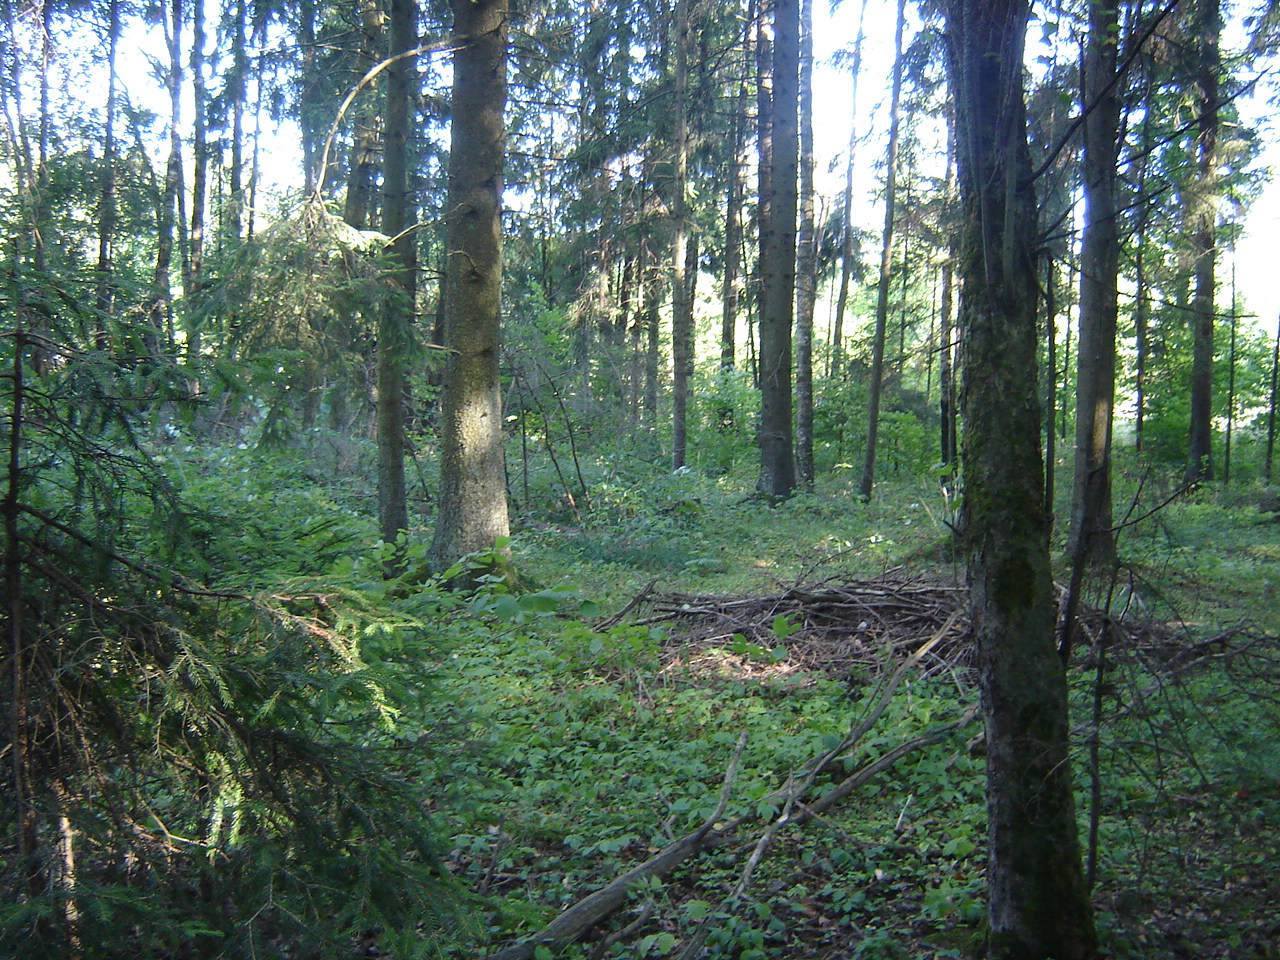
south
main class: Woodland
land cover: Spruce dominated mixed woodland
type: hemiboreal forest and nemoral coniferous forest and mixed broadleaved-coniferous forest
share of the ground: > 75 %
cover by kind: coniferous forest trees 60 %, broadleaved forest trees 30 %, herbaceous plants 5 %, unconsolidated bare surface 5 %
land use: Forestry
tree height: > 5 m
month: August
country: LT
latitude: 55.0363
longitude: 24.8974
